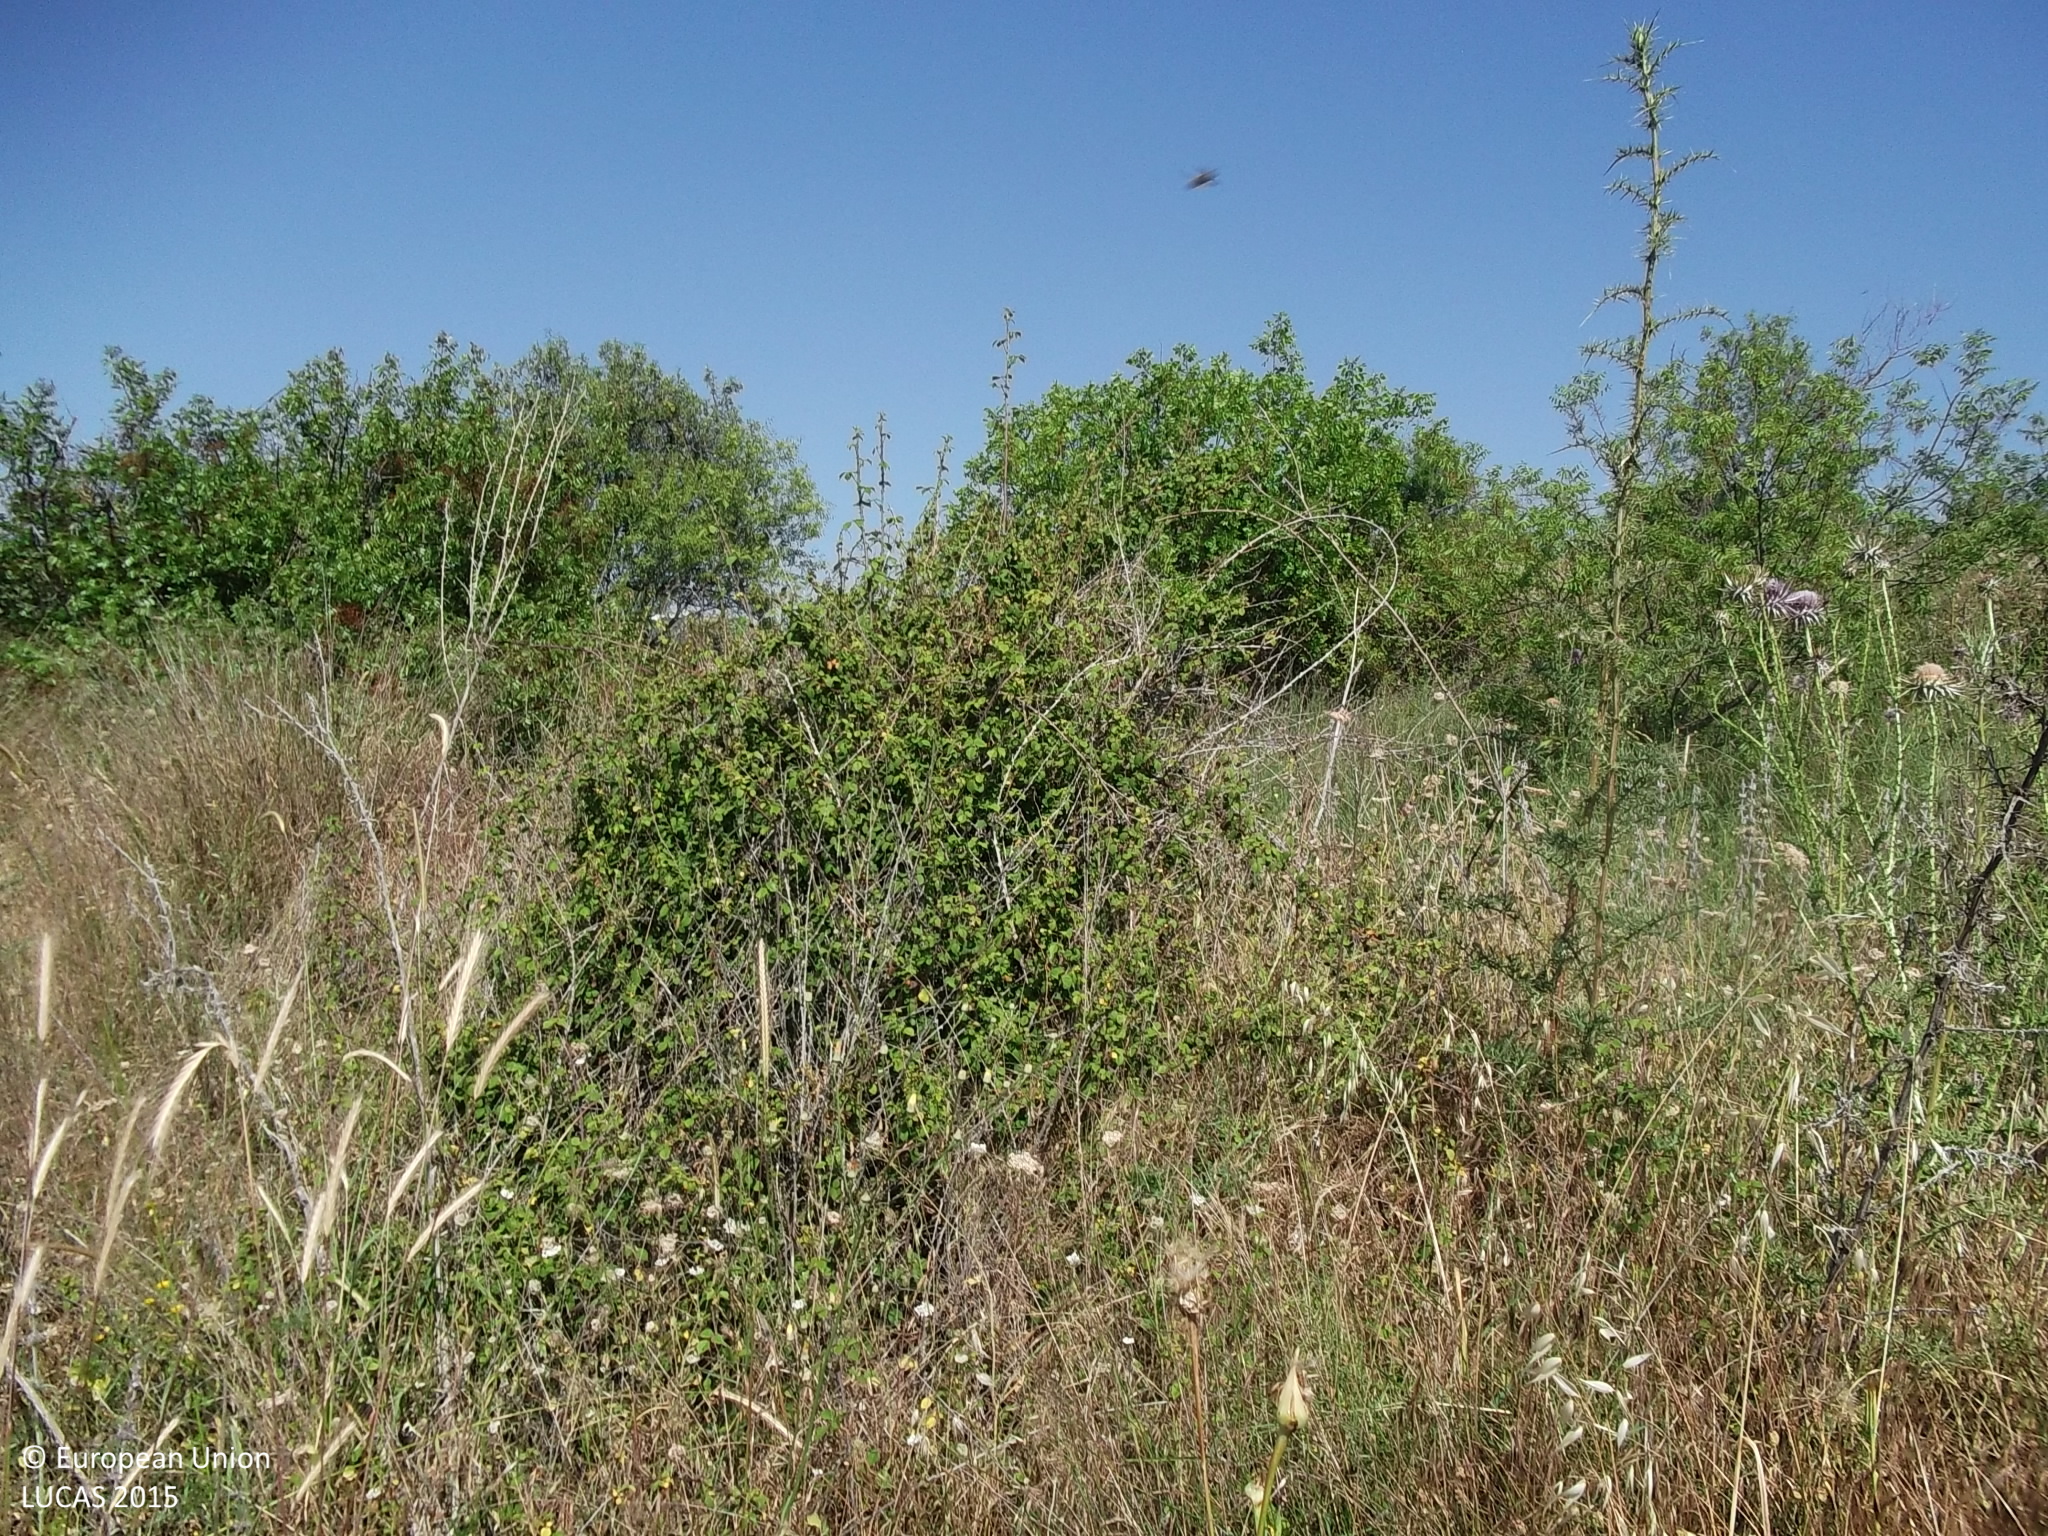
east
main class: Grassland
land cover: Grassland with sparse tree/shrub cover
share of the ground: > 75 %
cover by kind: herbaceous plants 90 %, broadleaved forest trees 5 %, shrubs 5 %
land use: Semi-natural and natural areas not in use
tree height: < 5 m
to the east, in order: Grassland with sparse tree/shrub cover; Shrubland without tree cover; Spontaneously vegetated surfaces; Lines of trees; Paved roads, cycling and walking lanes; Rock outcrops; Shrubland without tree cover; Shrubland with sparse tree cover; Broadleaved woodland
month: May
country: CY
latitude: 34.8835
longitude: 32.5724
